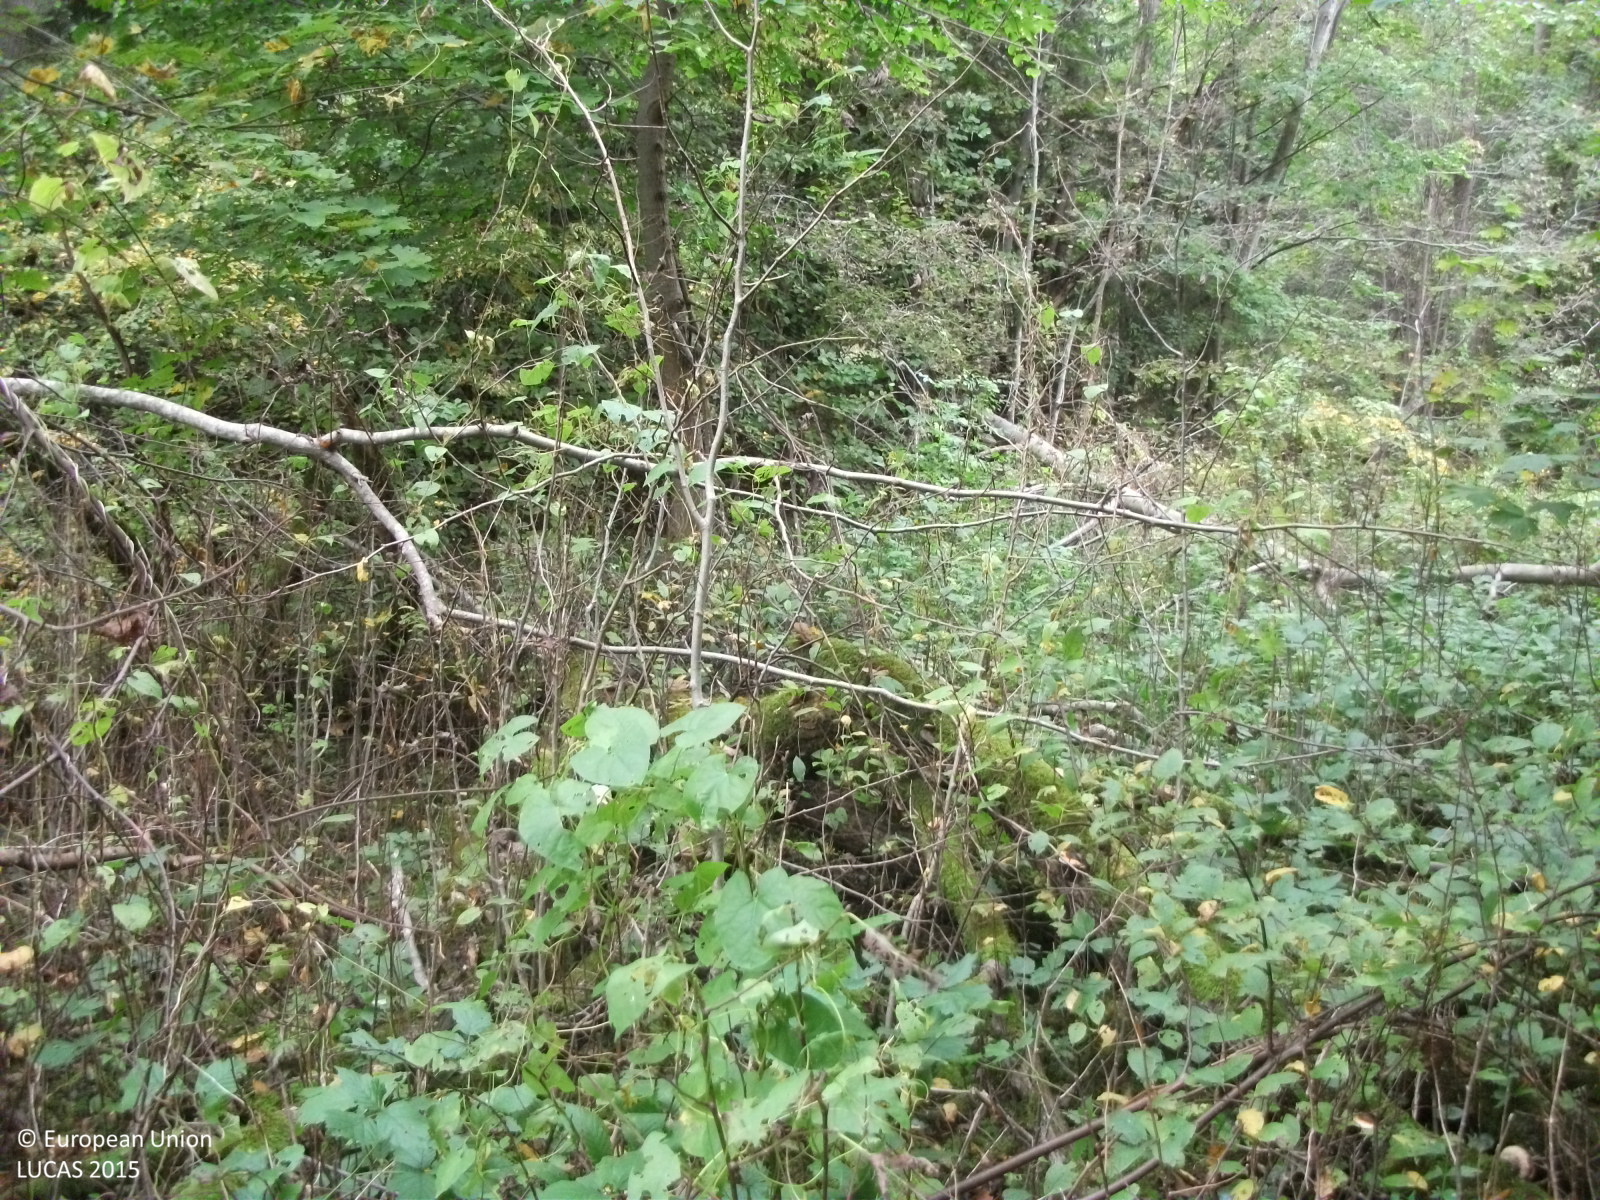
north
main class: Grassland
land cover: Spontaneously vegetated surfaces
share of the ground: > 75 %
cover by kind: herbaceous plants 100 %
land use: Semi-natural and natural areas not in use
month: September
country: LV
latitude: 57.6525
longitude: 24.4500
